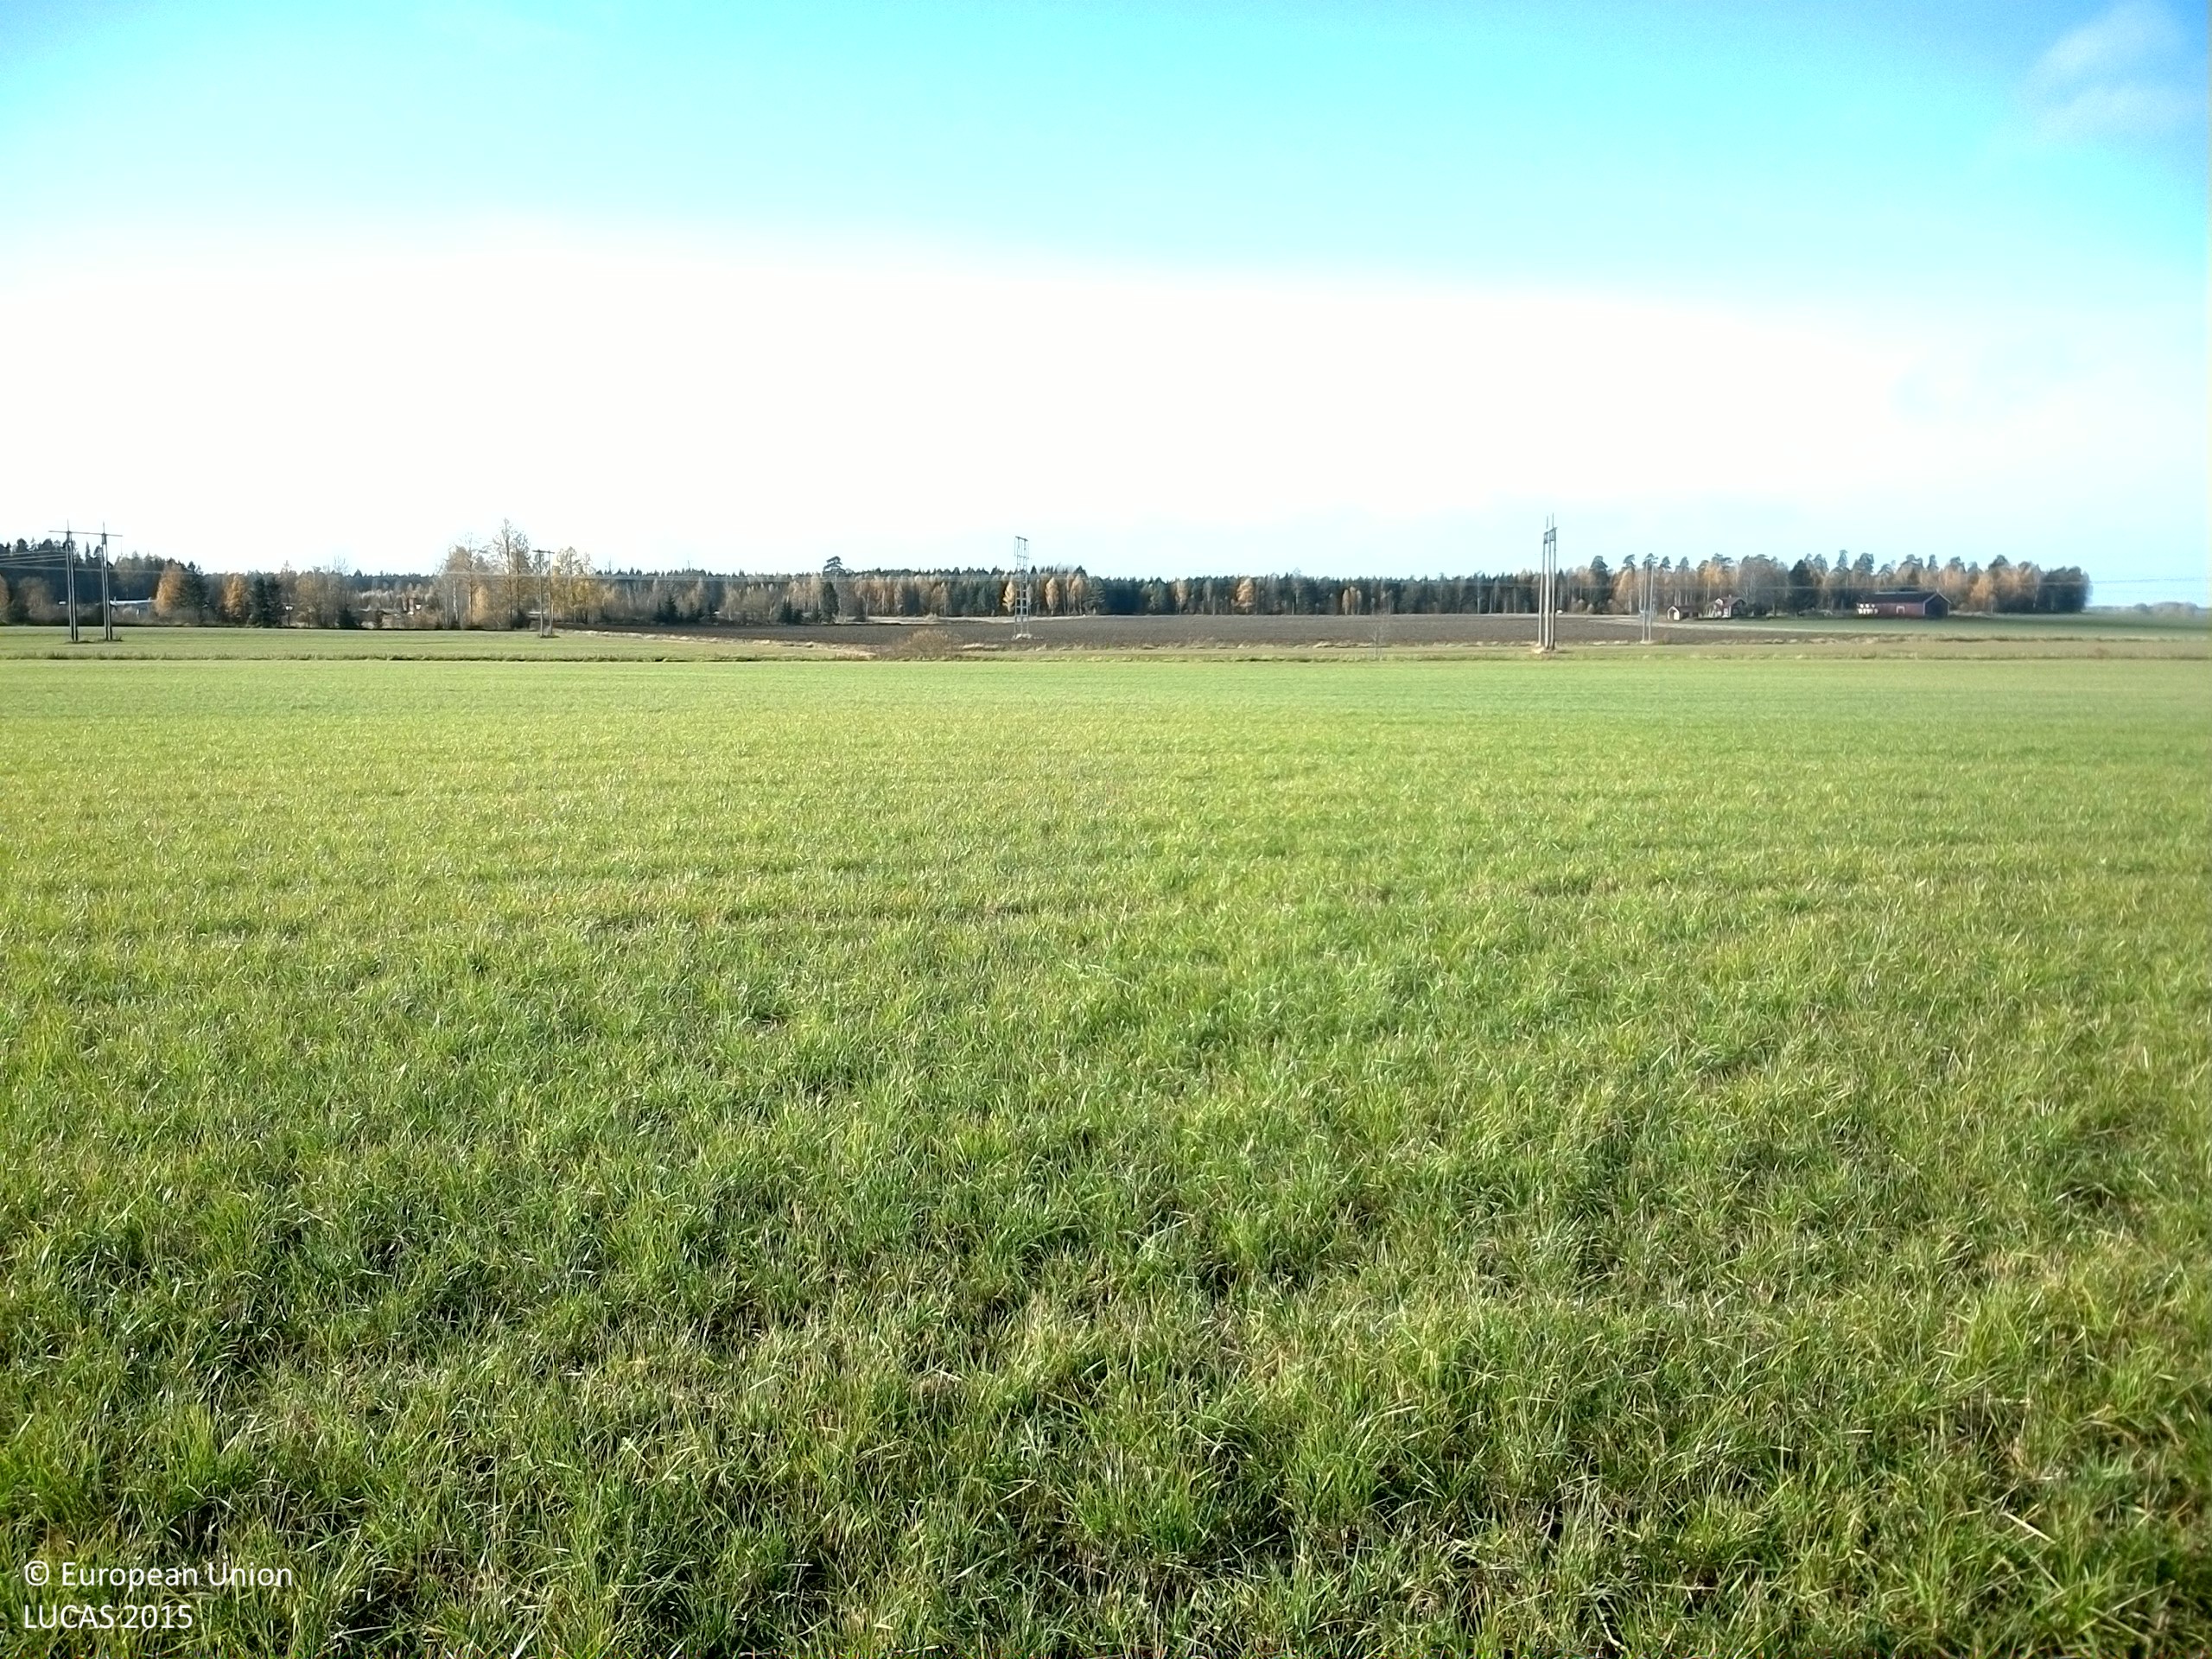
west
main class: Cropland
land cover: Temporary grasslands
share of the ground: > 75 %
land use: Agriculture (excluding fallow land and kitchen gardens)
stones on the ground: < 10 %
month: October
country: SE
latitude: 59.8124
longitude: 16.5347
